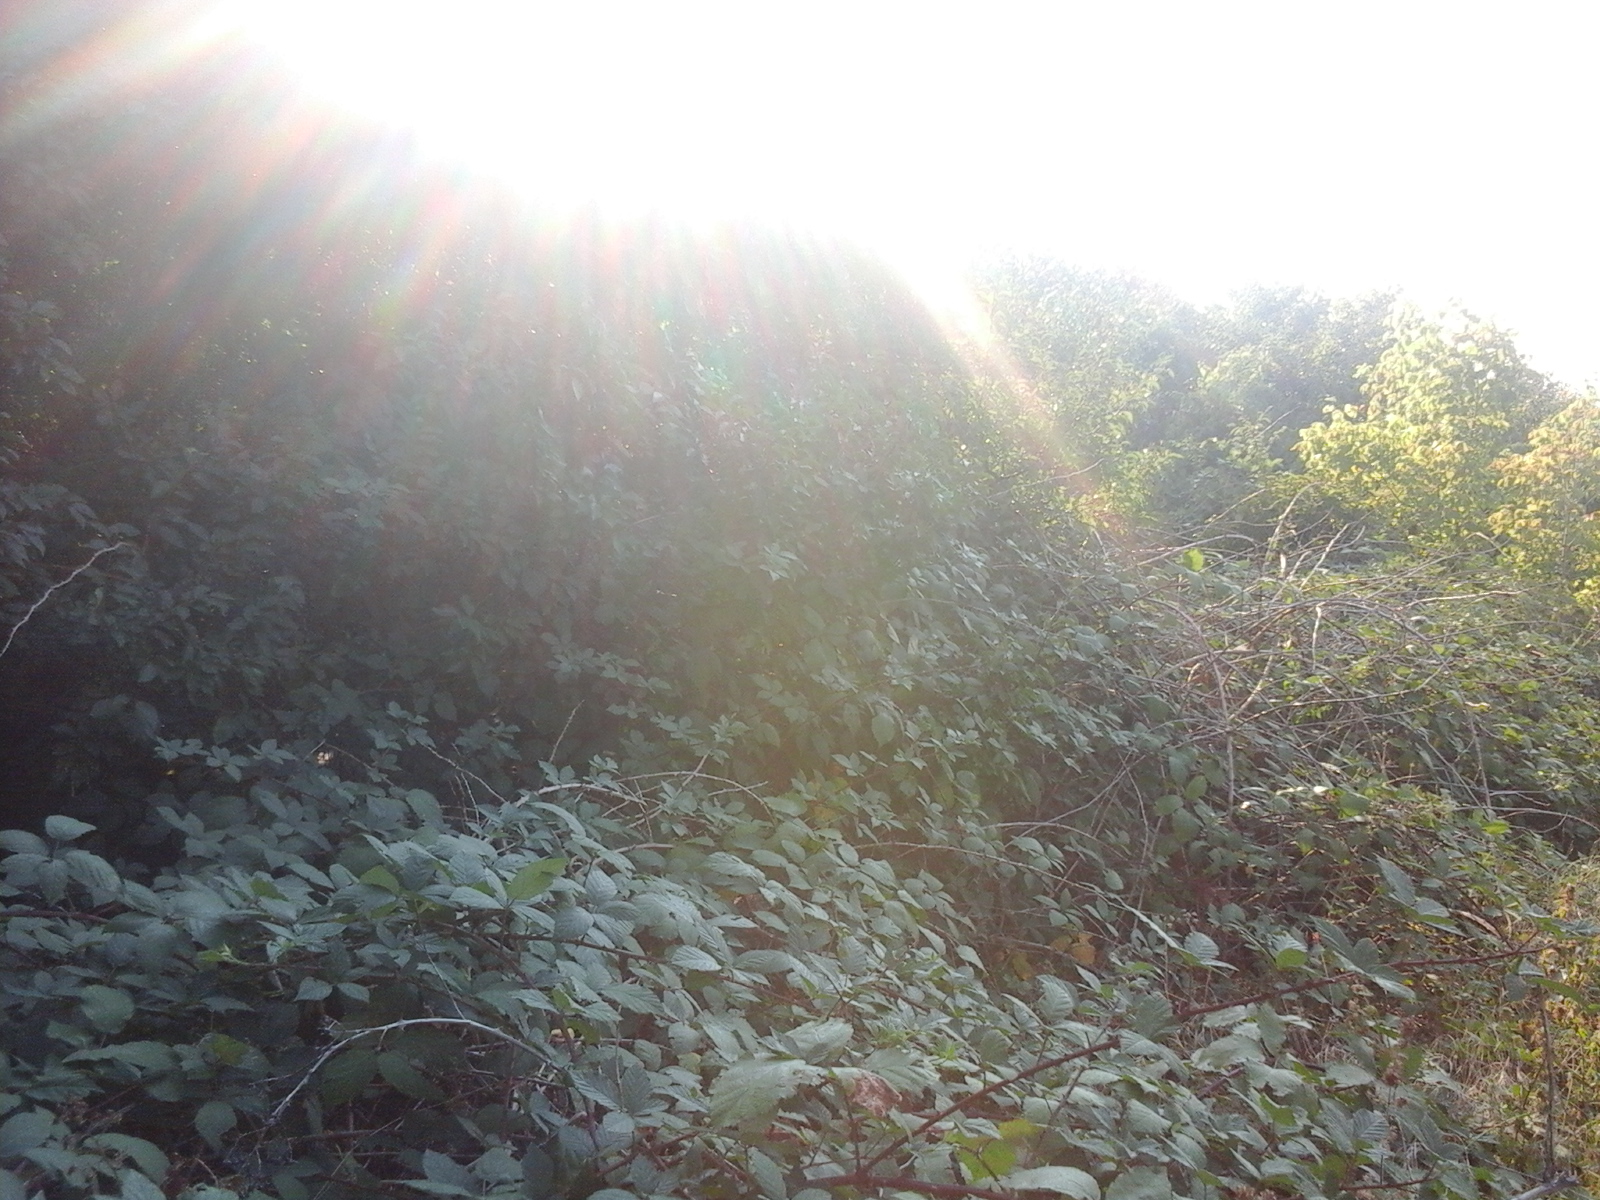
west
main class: Woodland
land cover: Broadleaved woodland
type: exotic forest
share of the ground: > 75 %
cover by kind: broadleaved forest trees 100 %
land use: Semi-natural and natural areas not in use
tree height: > 5 m
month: August
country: RO
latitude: 44.3385
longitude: 23.7907
